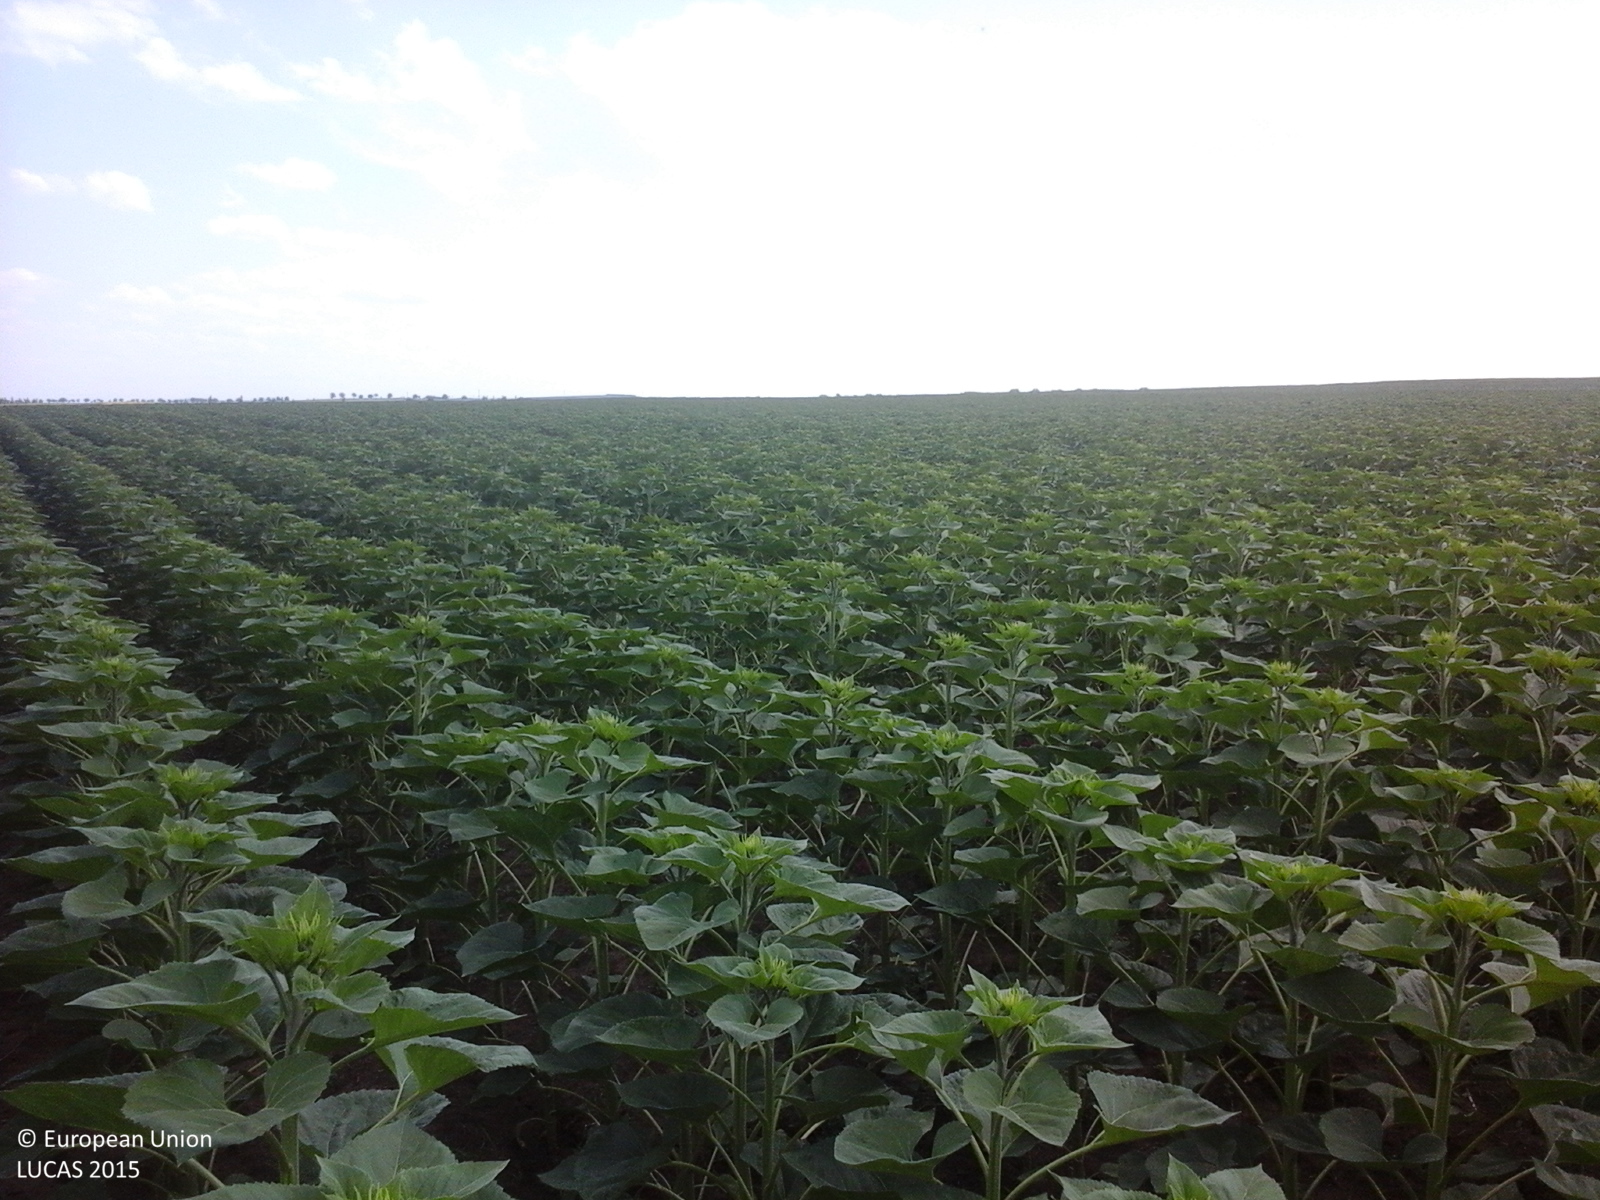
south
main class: Cropland
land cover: Sunflower
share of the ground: > 75 %
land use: Agriculture (excluding fallow land and kitchen gardens)
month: June
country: RO
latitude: 47.8988
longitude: 26.4220
